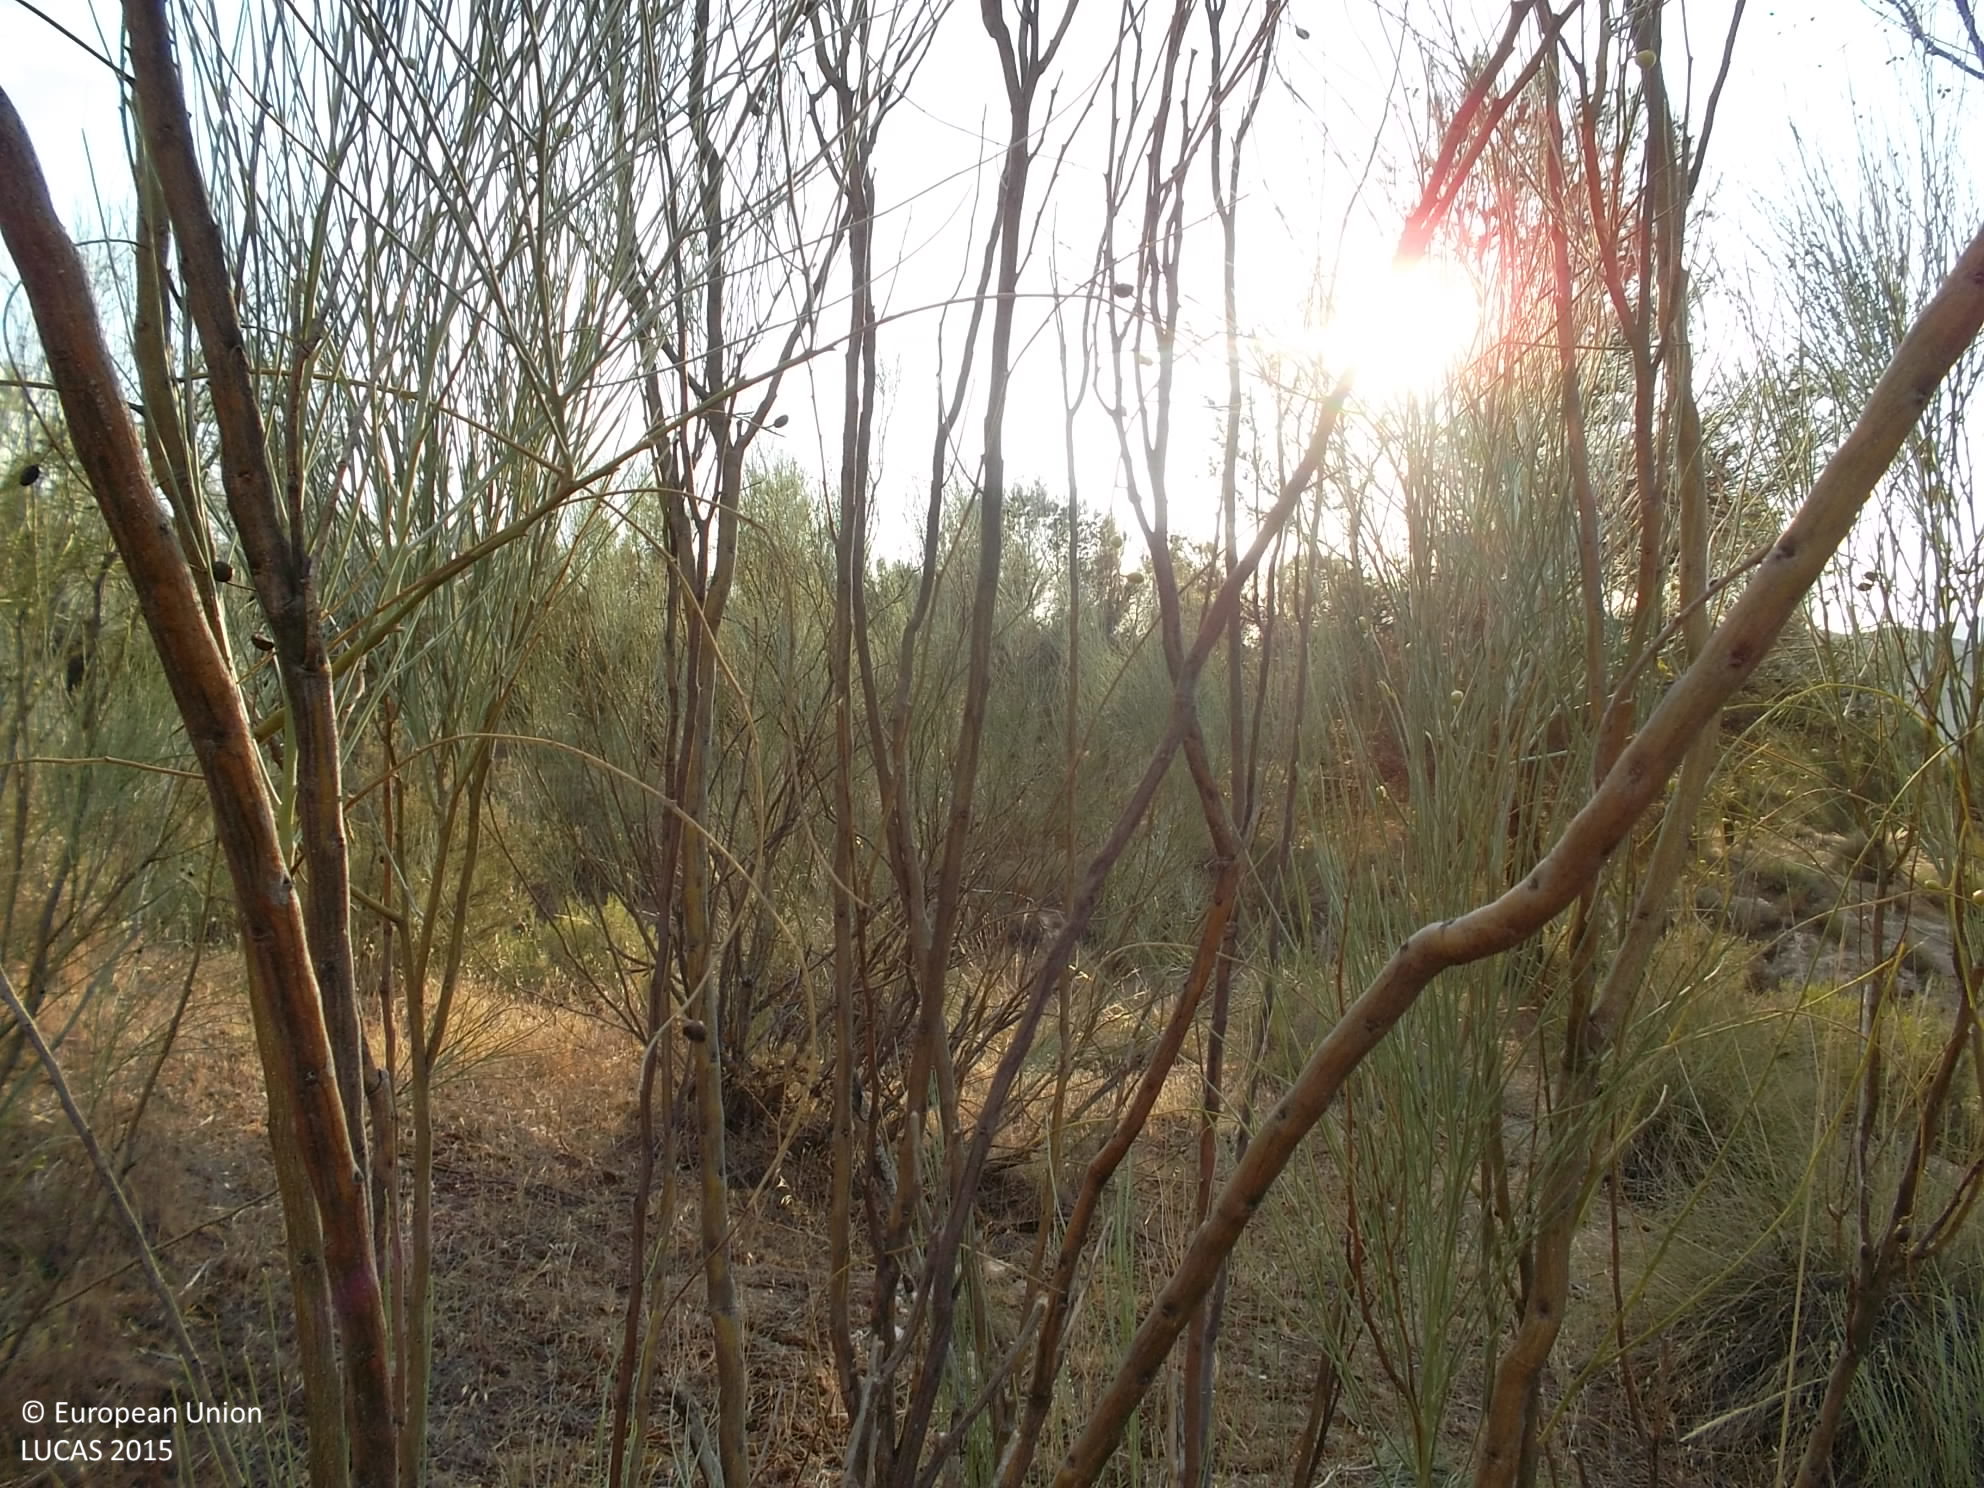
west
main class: Woodland
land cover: Pine dominated coniferous woodland
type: coniferous forest of the mediterranean region
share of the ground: 25 - 50 %
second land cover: Shrubland without tree cover
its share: 25 - 50 %
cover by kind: shrubs 40 %, coniferous forest trees 30 %, herbaceous plants 30 %
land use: Forestry
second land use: Agriculture (excluding fallow land and kitchen gardens)
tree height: > 5 m
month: June
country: ES
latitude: 37.8097
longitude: -3.2285
